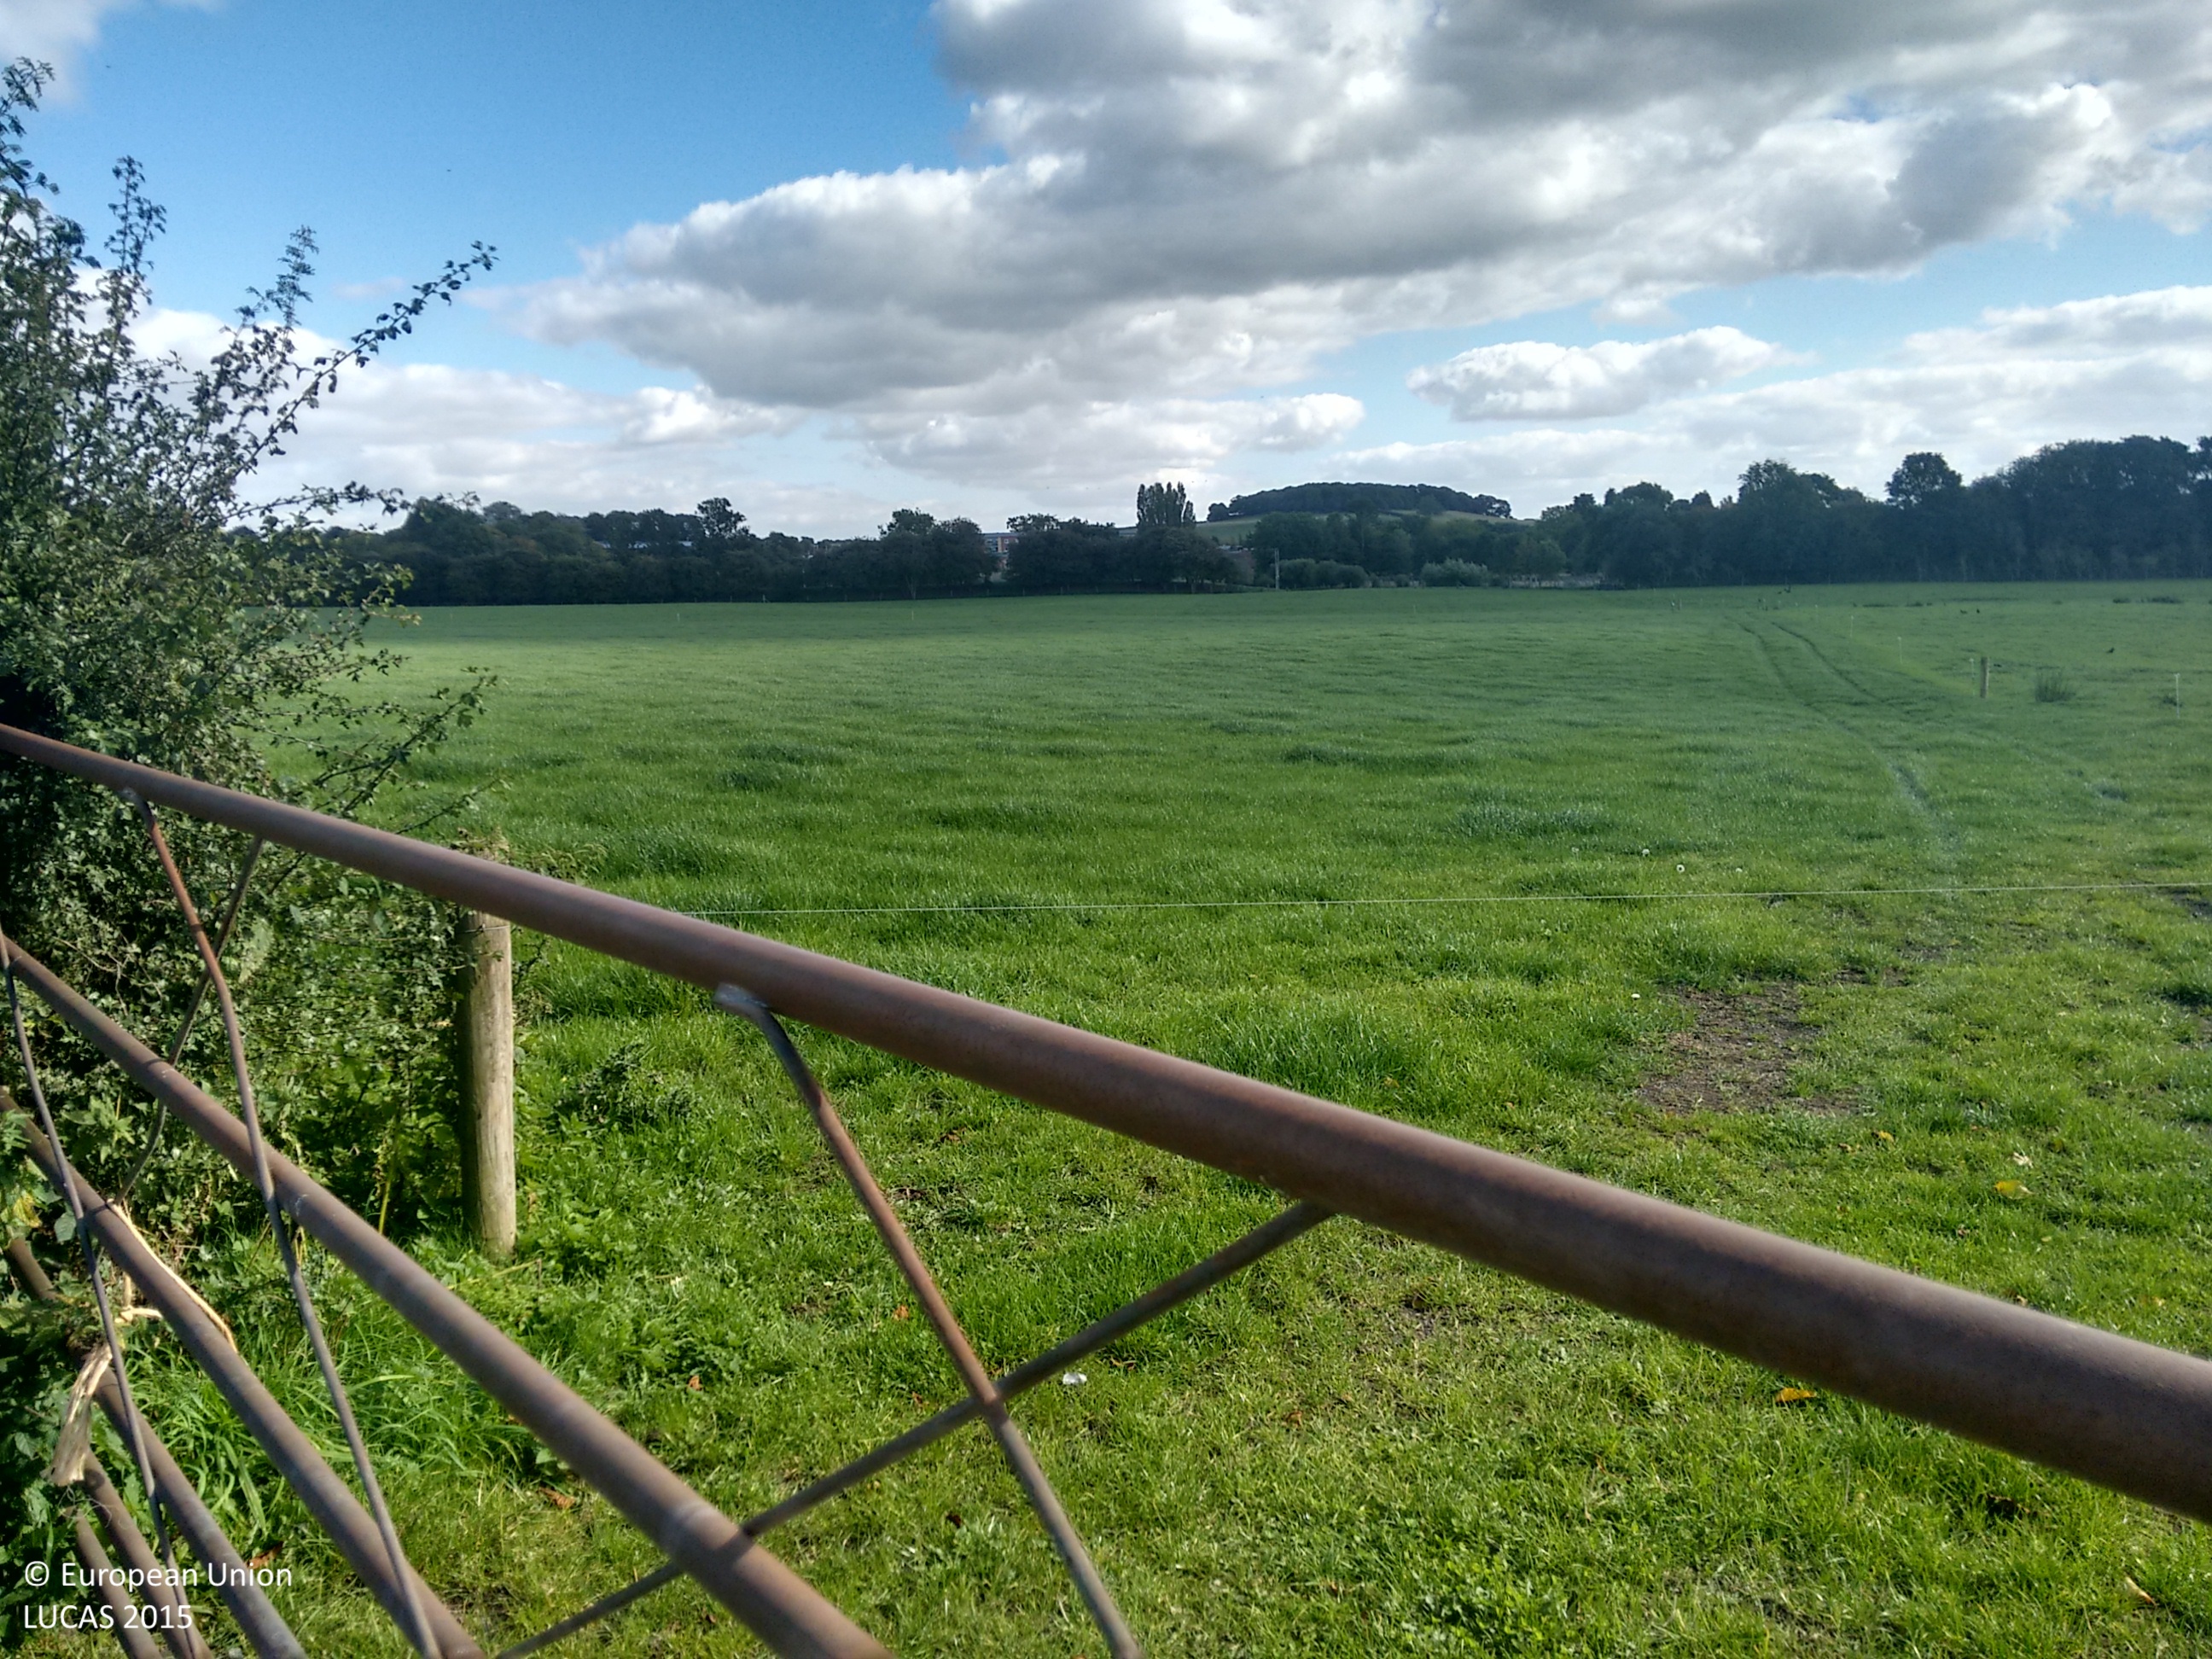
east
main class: Grassland
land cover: Grassland without tree/shrub cover
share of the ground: > 75 %
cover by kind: herbaceous plants 100 %
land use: Agriculture (excluding fallow land and kitchen gardens)
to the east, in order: Grassland without tree/shrub cover; Single bushes/trees; Managed hedges; Grassland without tree/shrub cover; Managed hedges; Fences; Grassland without tree/shrub cover; Grassland with sparse tree/shrub cover
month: September
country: GB
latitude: 52.8292
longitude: -2.0965
